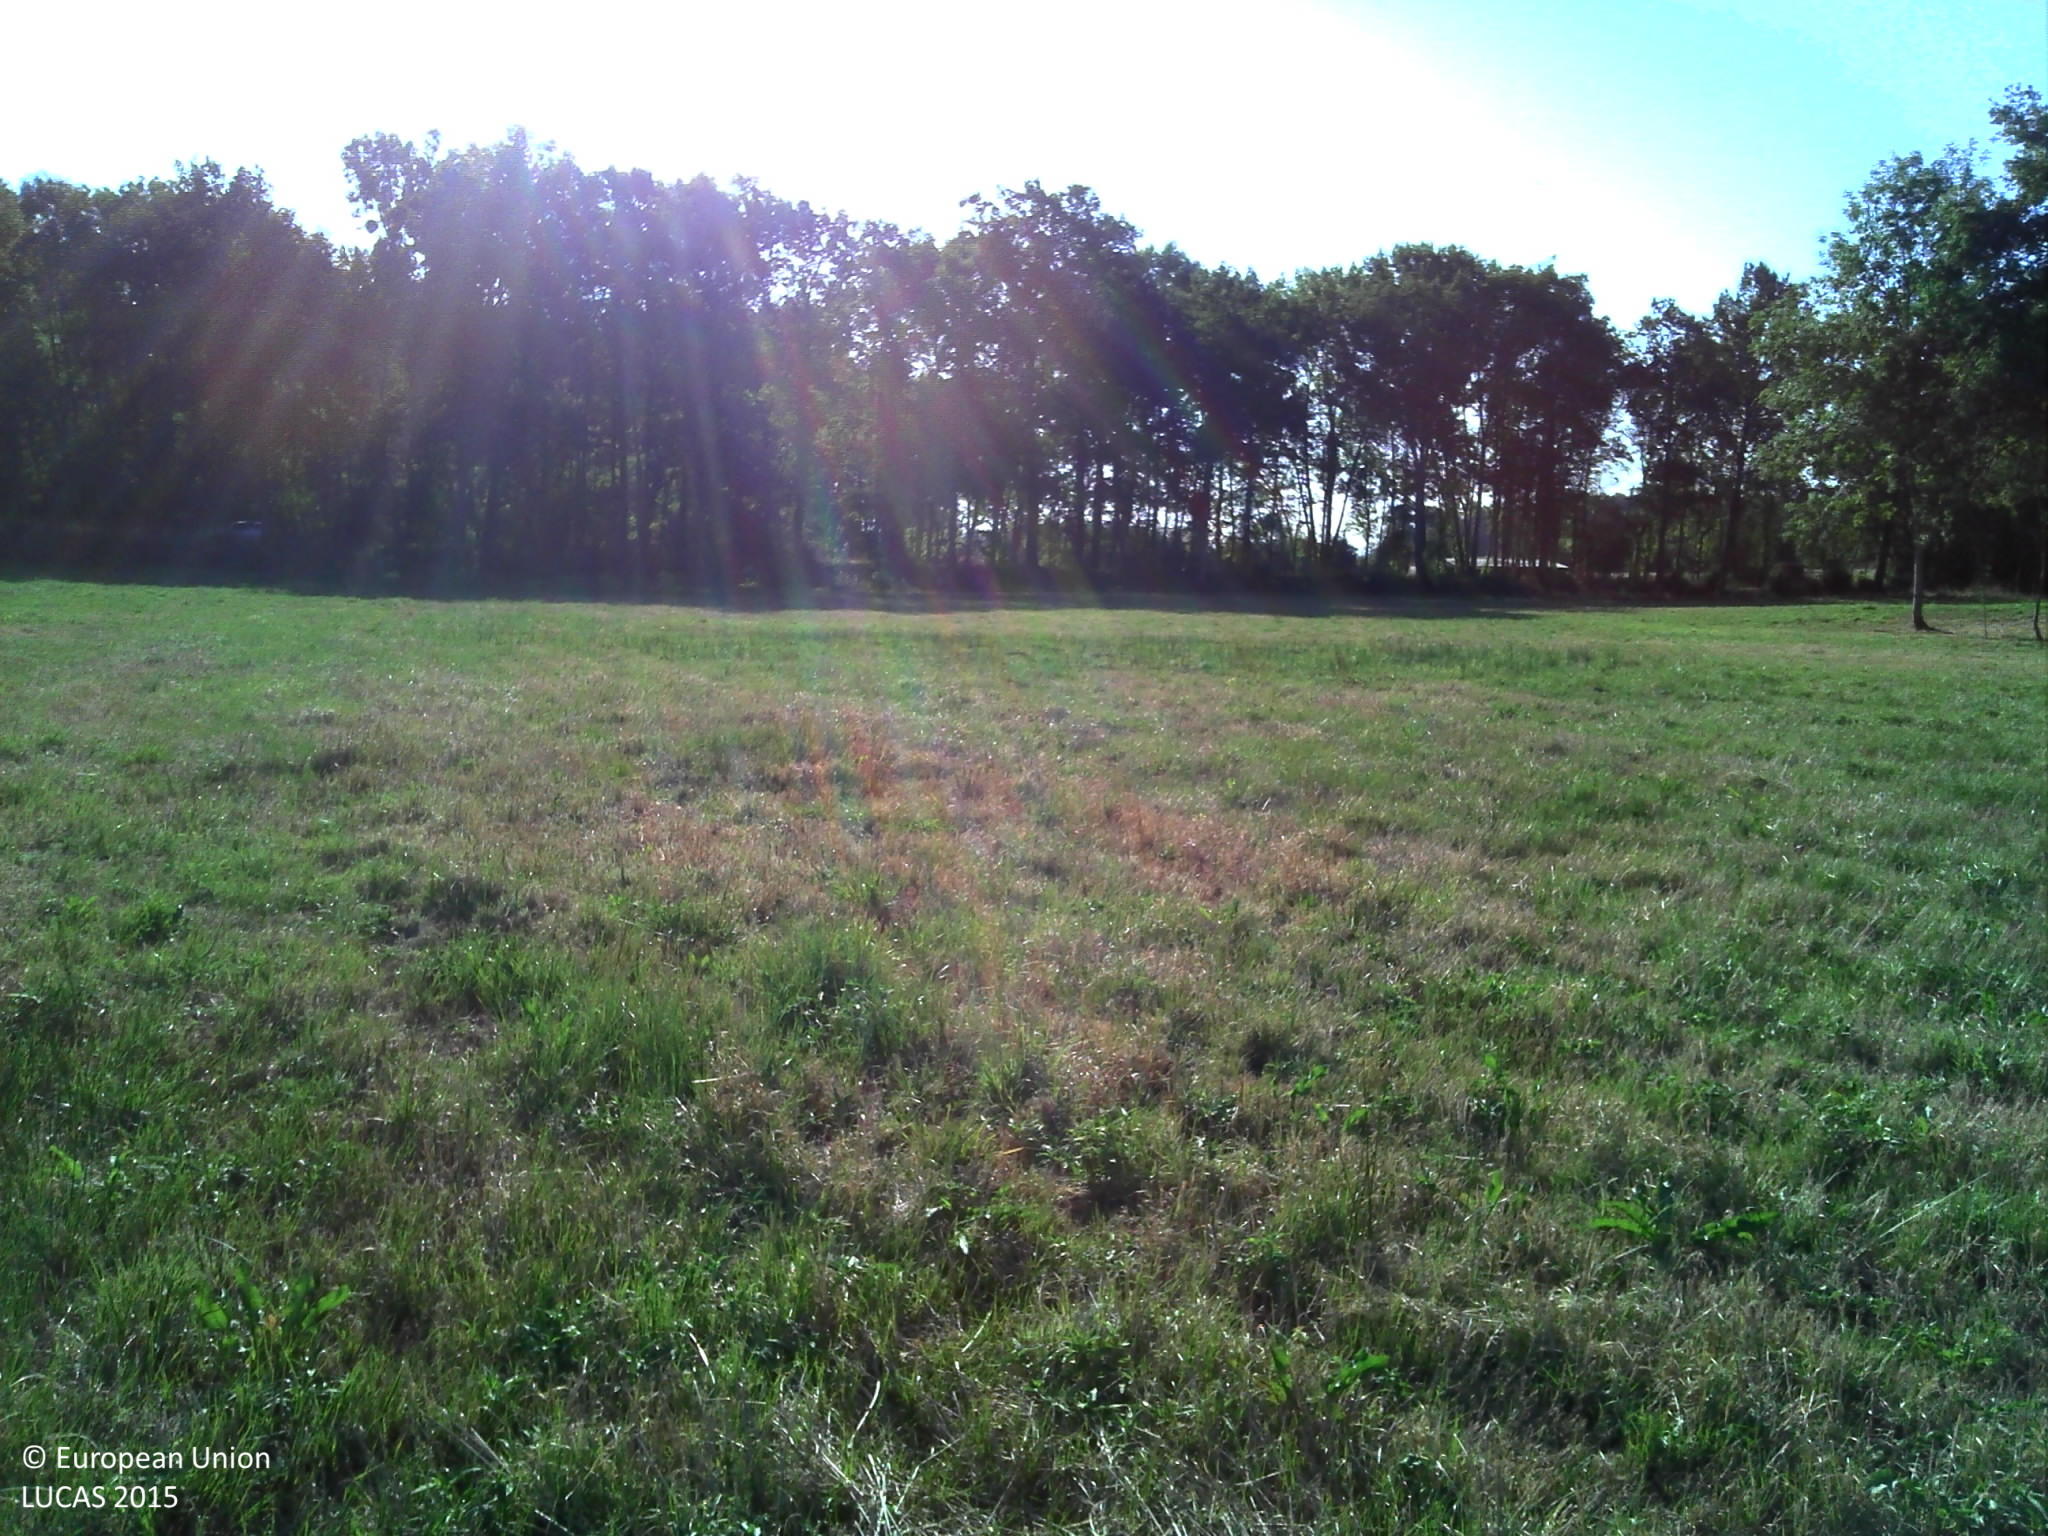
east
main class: Grassland
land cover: Grassland without tree/shrub cover
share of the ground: > 75 %
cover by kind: herbaceous plants 100 %
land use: Agriculture (excluding fallow land and kitchen gardens)
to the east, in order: Grassland without tree/shrub cover; Ditches and canals; Lines of trees; Grass margins; Tracks; Grass margins; Broadleaved woodland; Fences; Grassland without tree/shrub cover; Inland fresh water bodies; Grassland without tree/shrub cover; Fences; Broadleaved woodland
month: August
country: FR
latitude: 47.8130
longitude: 3.4649
